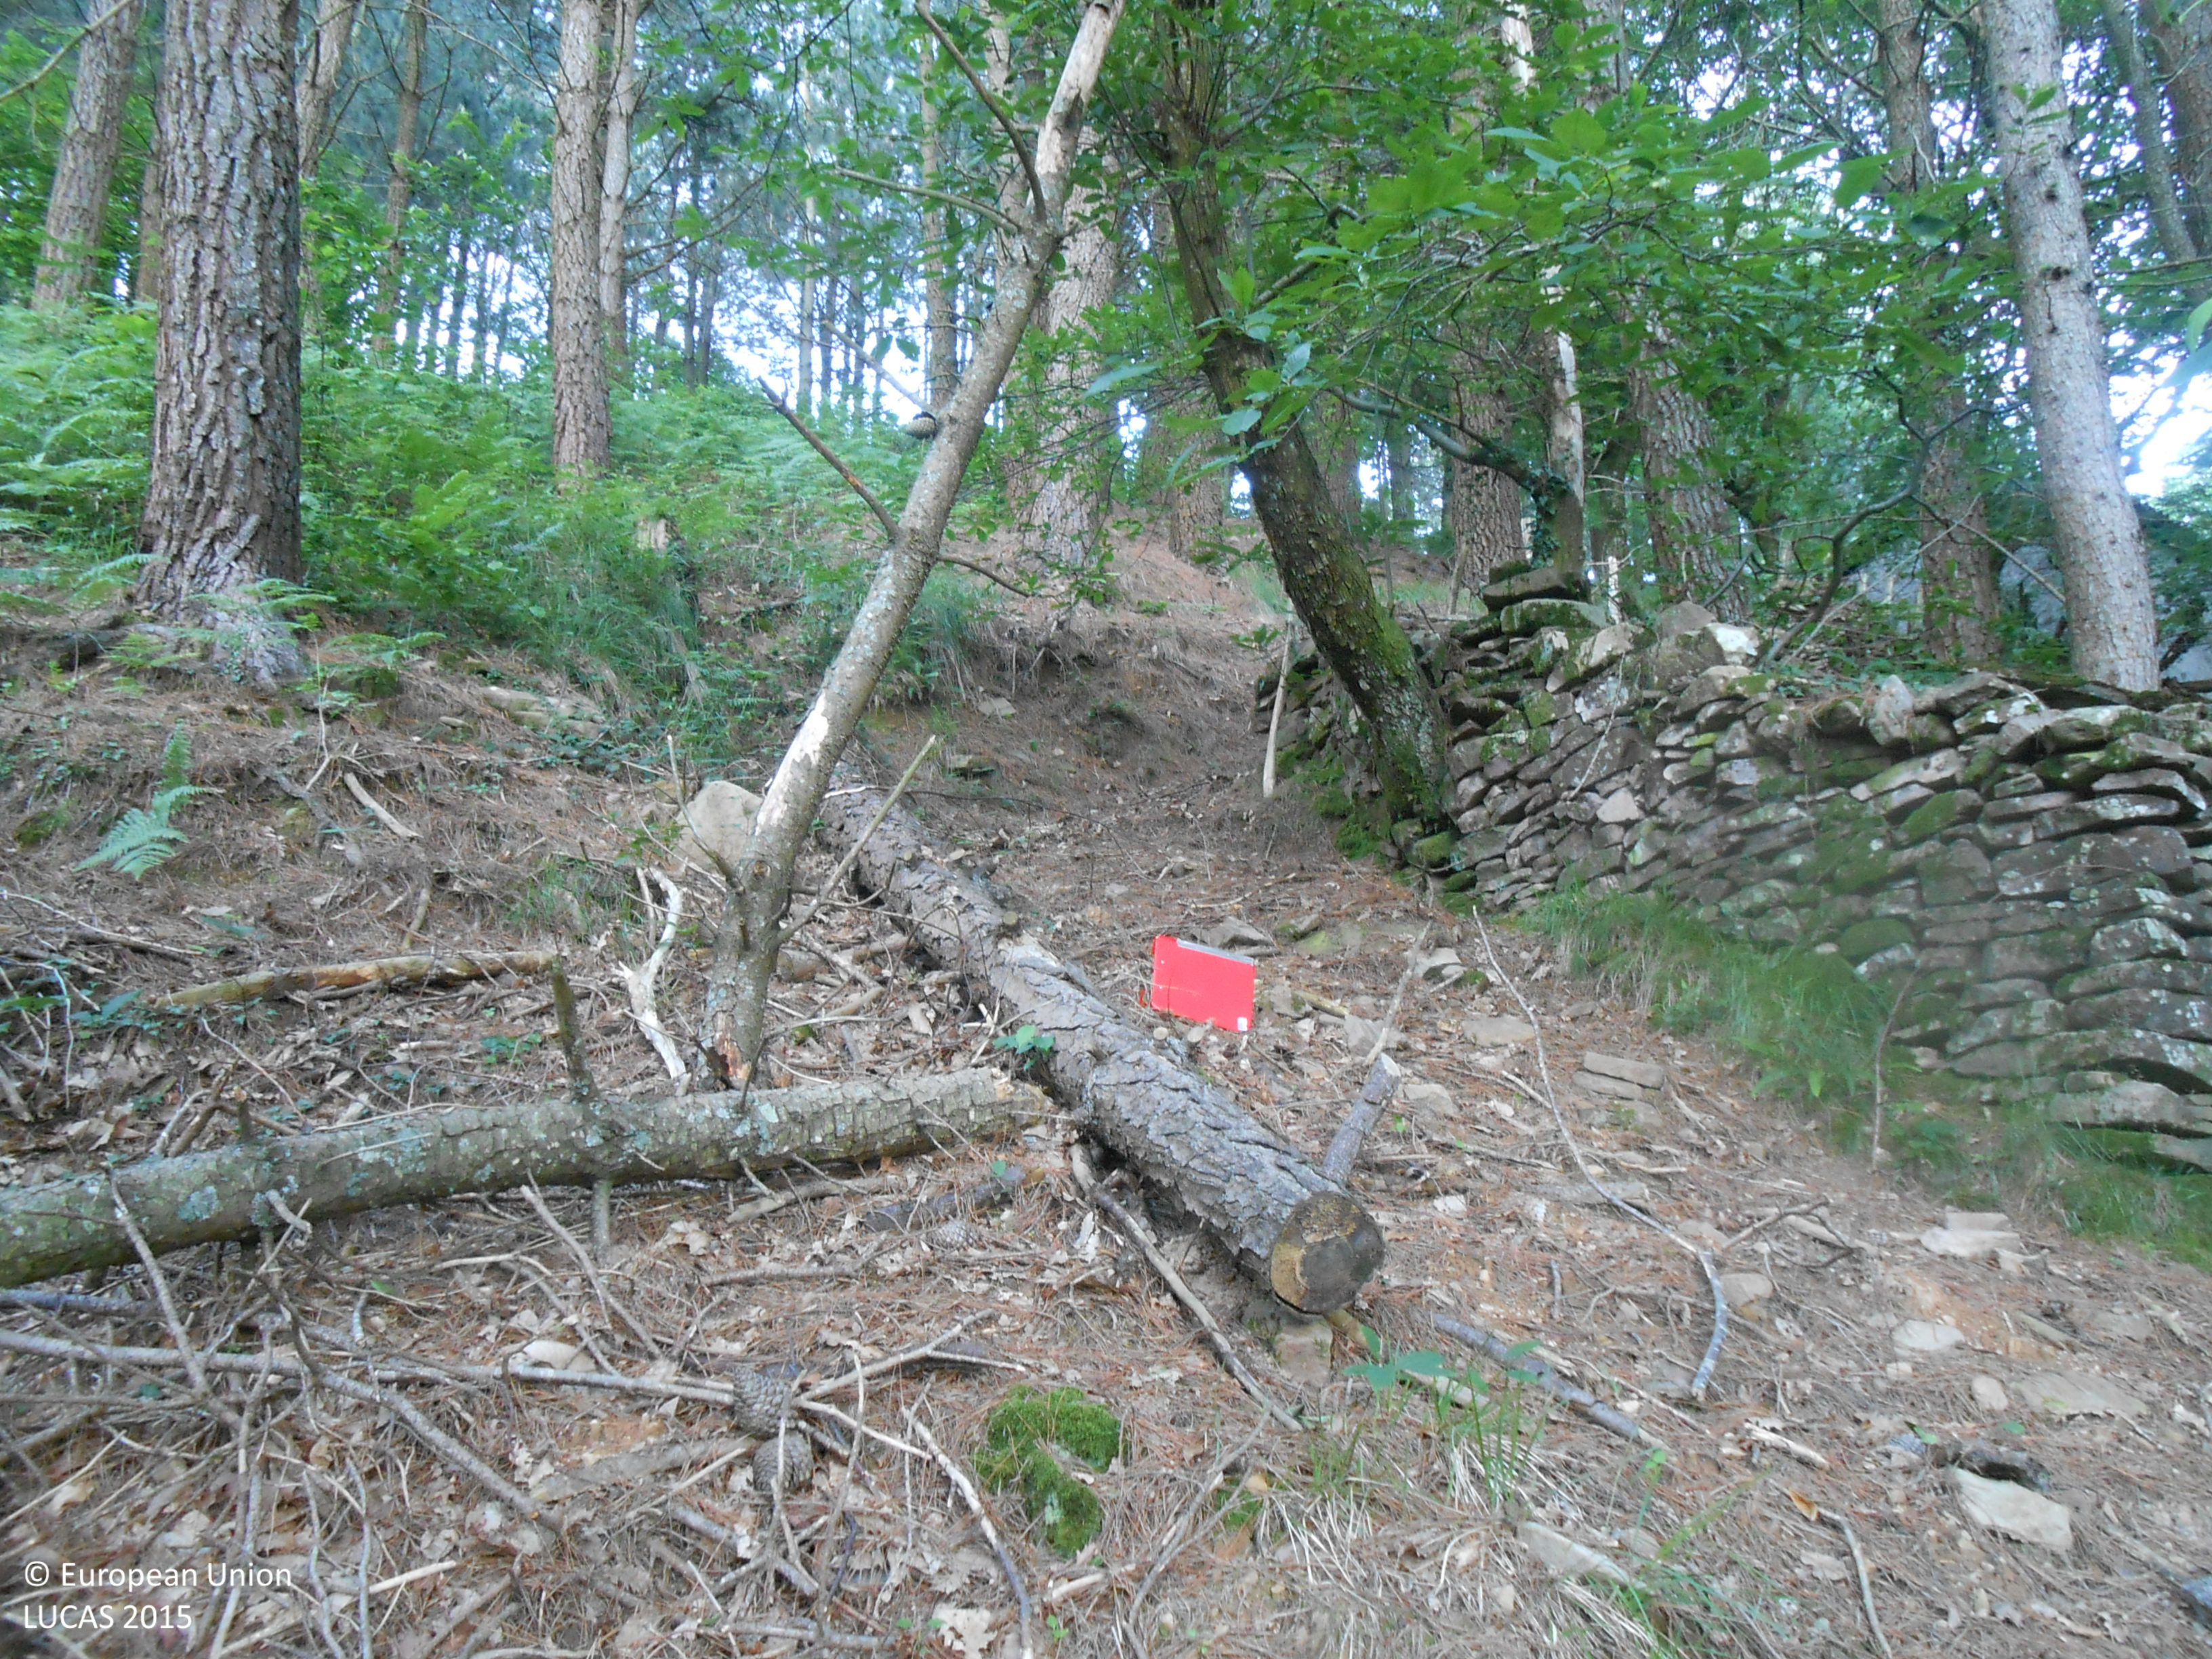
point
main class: Woodland
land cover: Pine dominated mixed woodland
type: hemiboreal forest and nemoral coniferous forest and mixed broadleaved-coniferous forest
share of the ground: > 75 %
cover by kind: coniferous forest trees 75 %, broadleaved forest trees 25 %
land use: Forestry
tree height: > 5 m
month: June
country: ES
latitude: 43.0890
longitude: -1.8242
